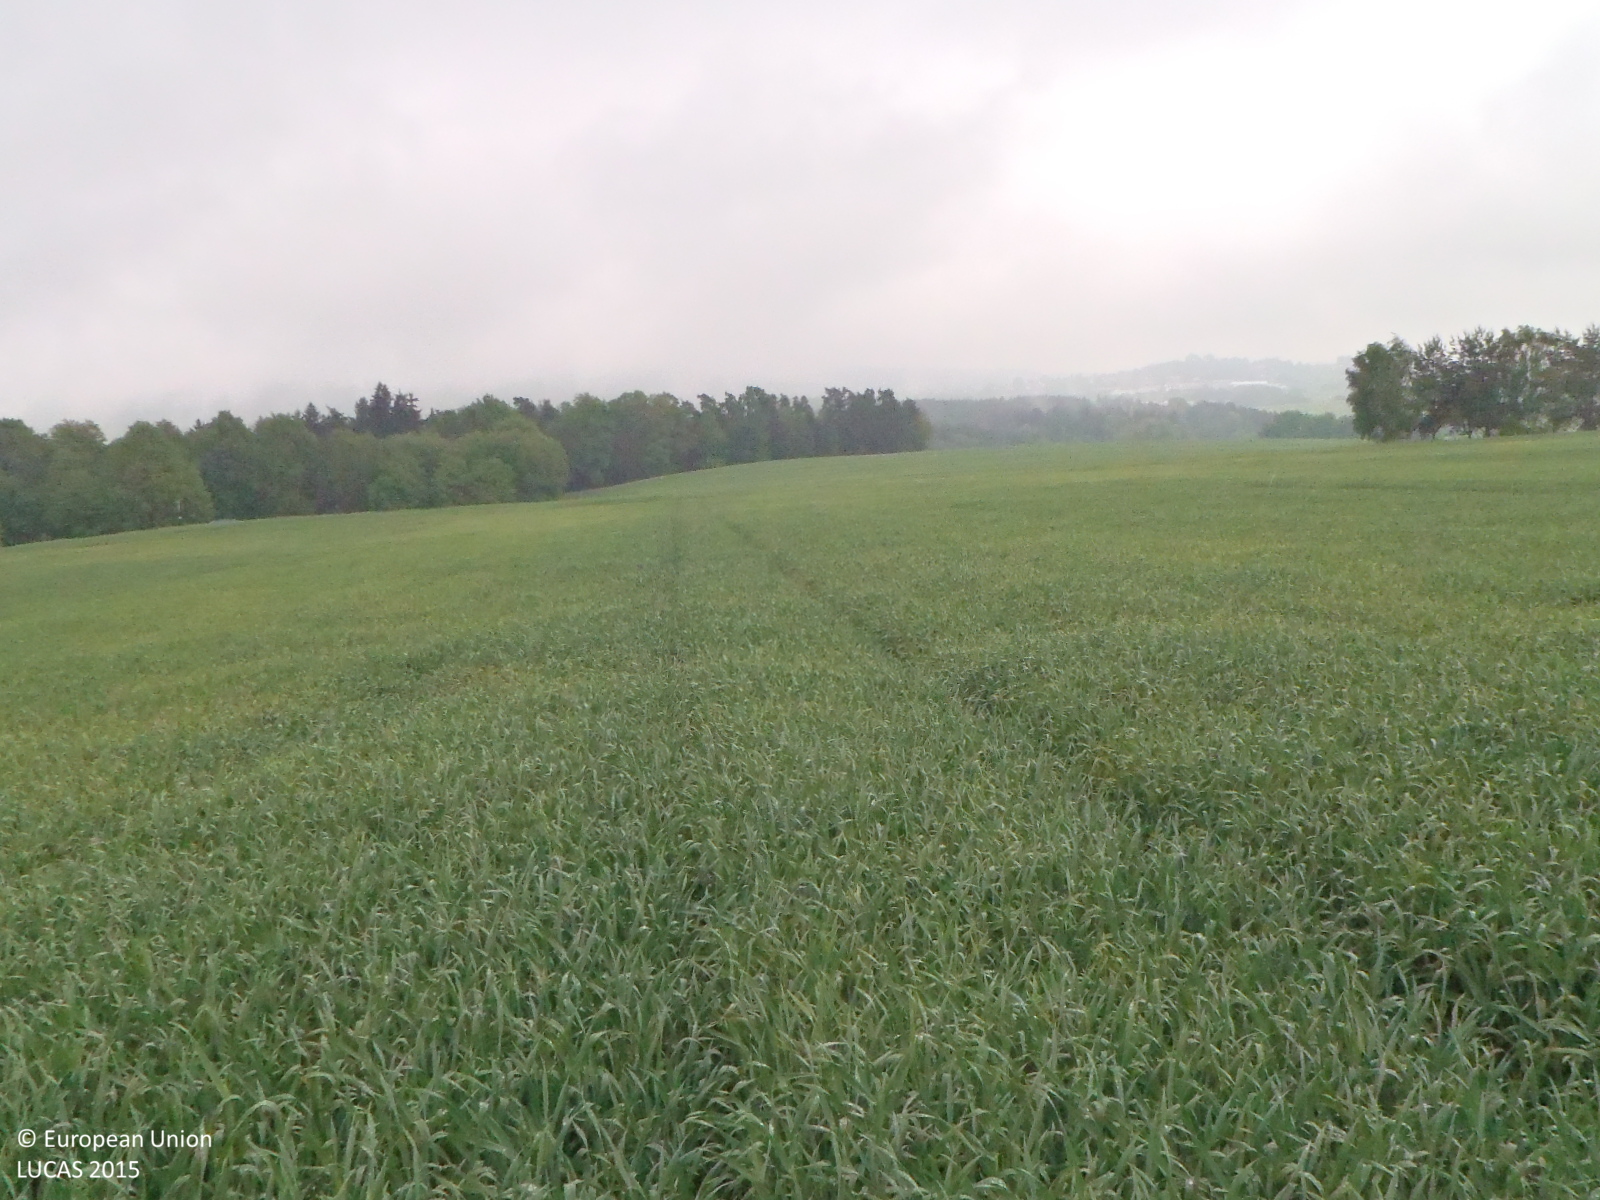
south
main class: Cropland
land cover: Triticale
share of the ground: > 75 %
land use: Agriculture (excluding fallow land and kitchen gardens)
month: May
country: CZ
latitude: 48.8139
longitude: 14.5632
